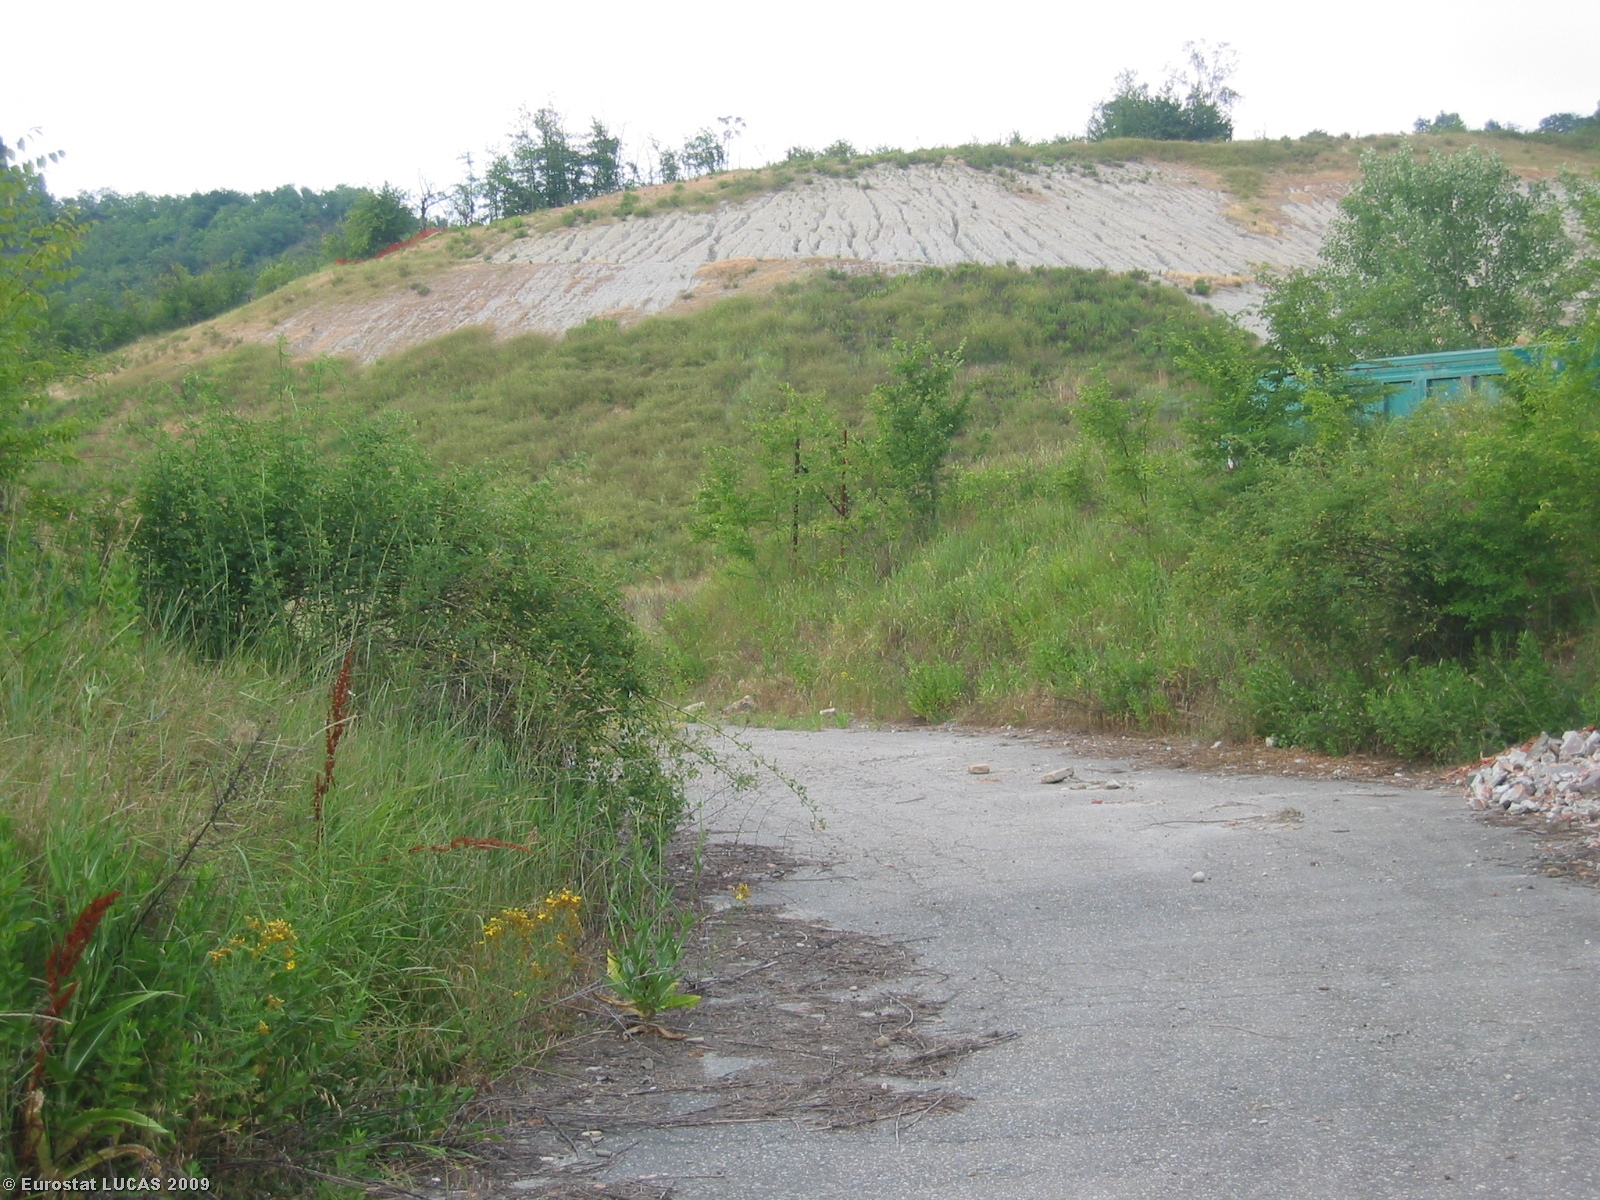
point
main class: Shrubland
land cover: Shrubland without tree cover
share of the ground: > 75 %
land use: Forestry
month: June
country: IT
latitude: 44.5277
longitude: 10.8161
